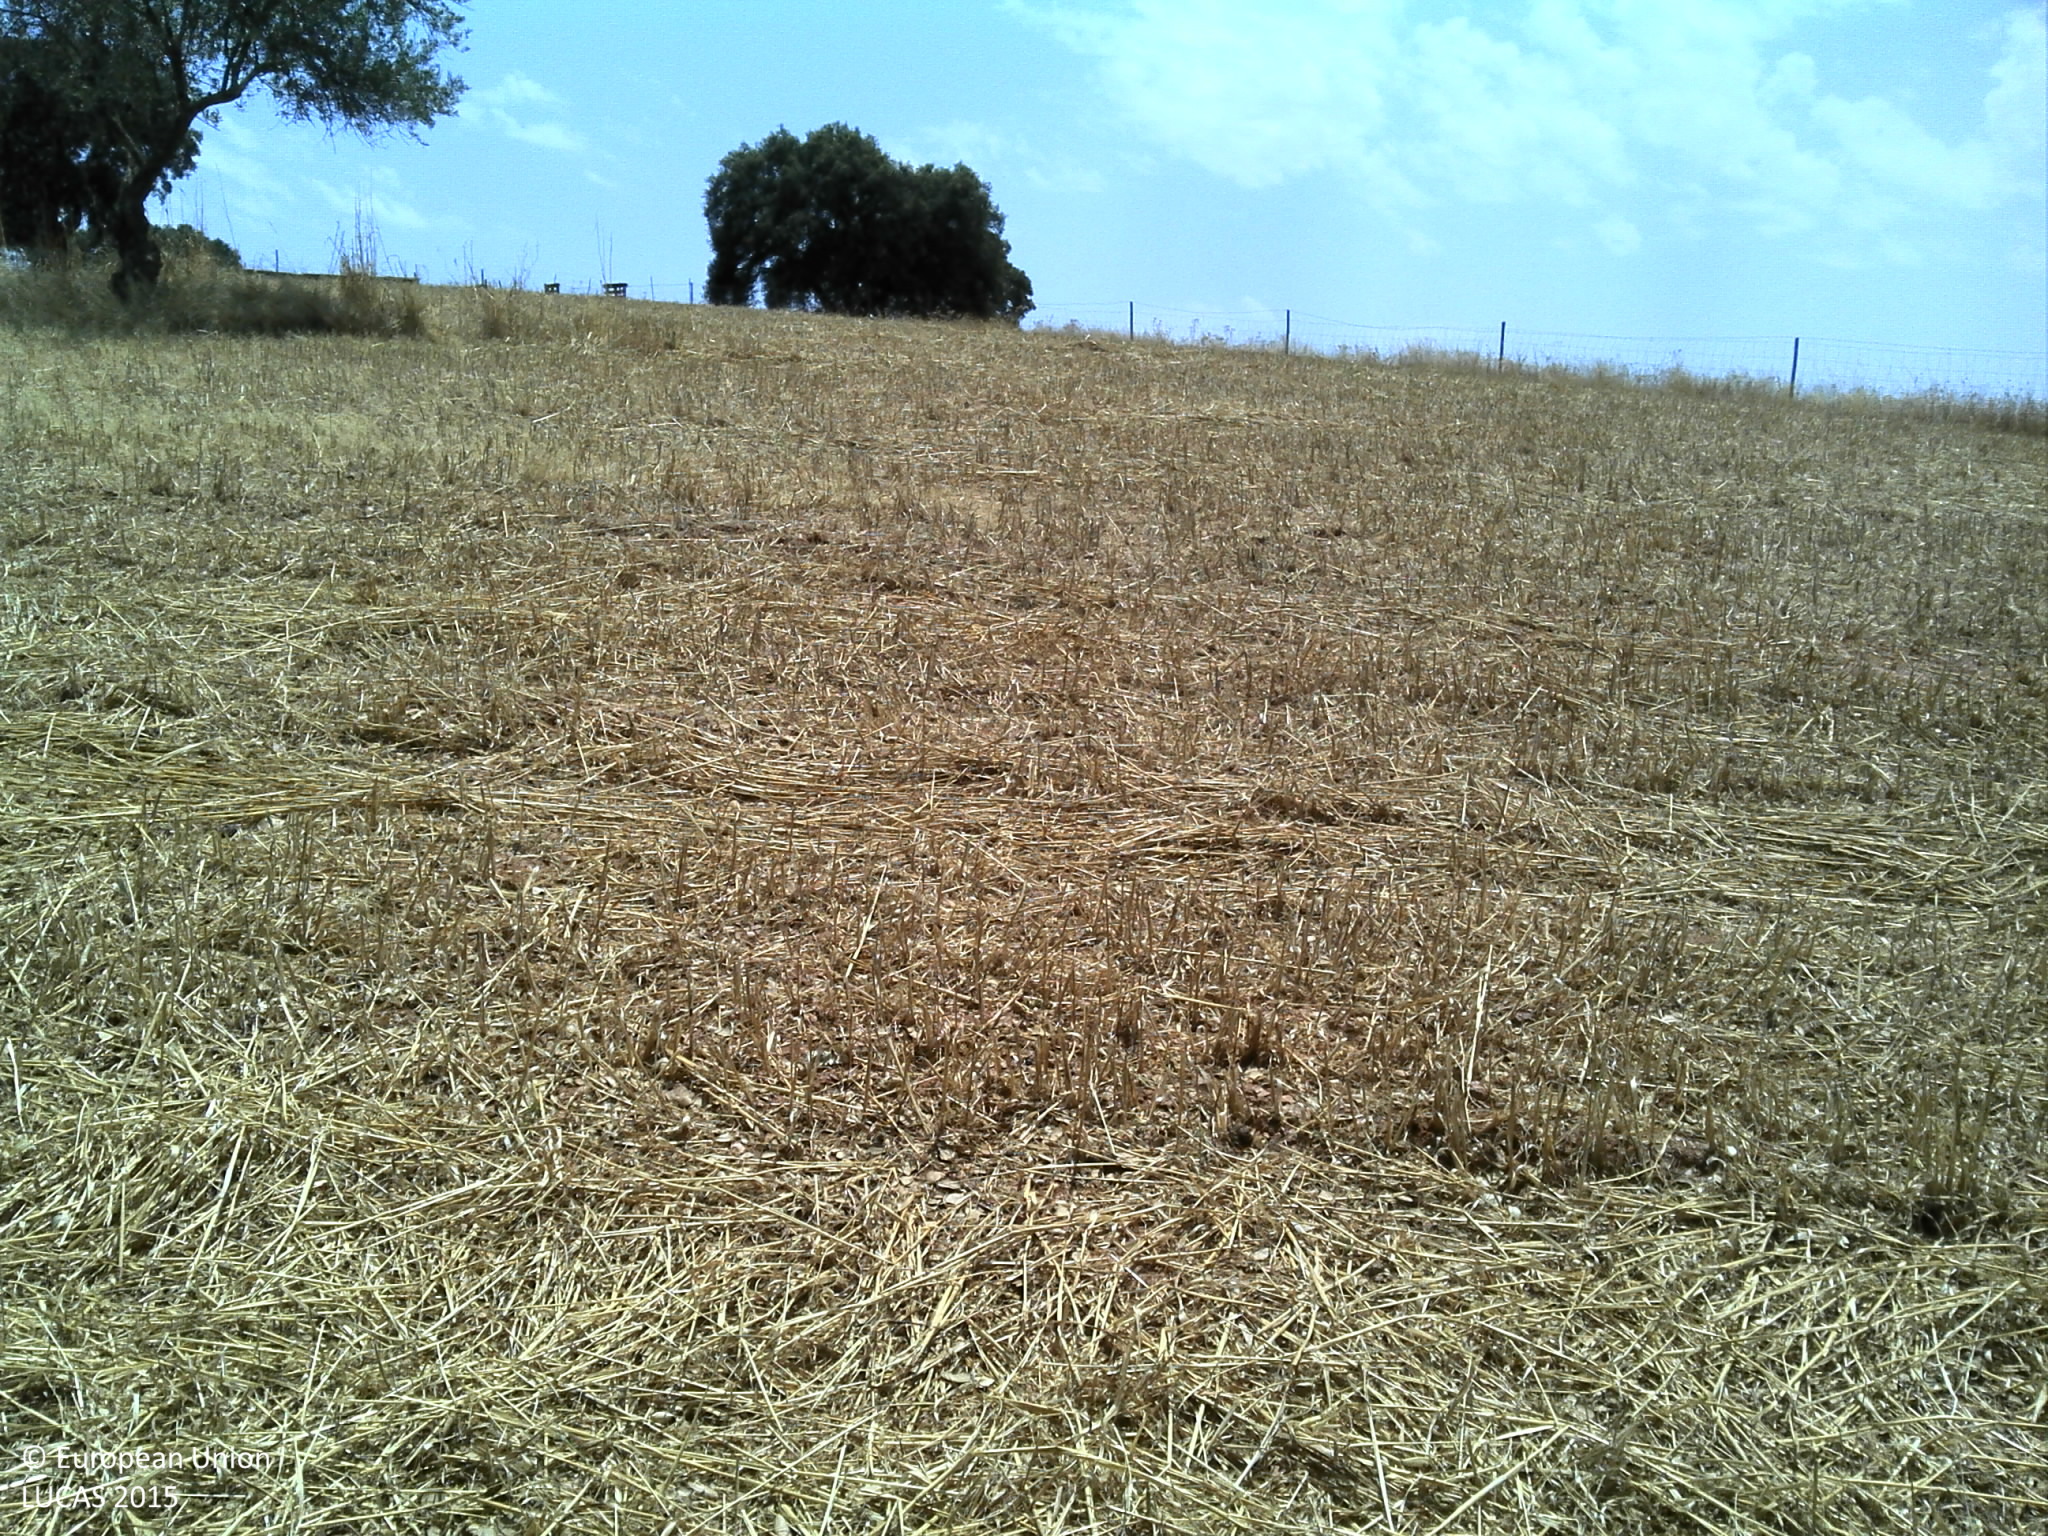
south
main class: Woodland
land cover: Broadleaved woodland
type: thermophilous deciduous forest
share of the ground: 25 - 50 %
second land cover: Grassland without tree/shrub cover
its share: 50 - 75 %
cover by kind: herbaceous plants 60 %, broadleaved forest trees 30 %, unconsolidated bare surface 10 %
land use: Forestry
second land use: Agriculture (excluding fallow land and kitchen gardens)
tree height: > 5 m
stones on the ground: < 10 %
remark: Harvested field
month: June
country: PT
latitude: 37.7694
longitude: -7.5322
